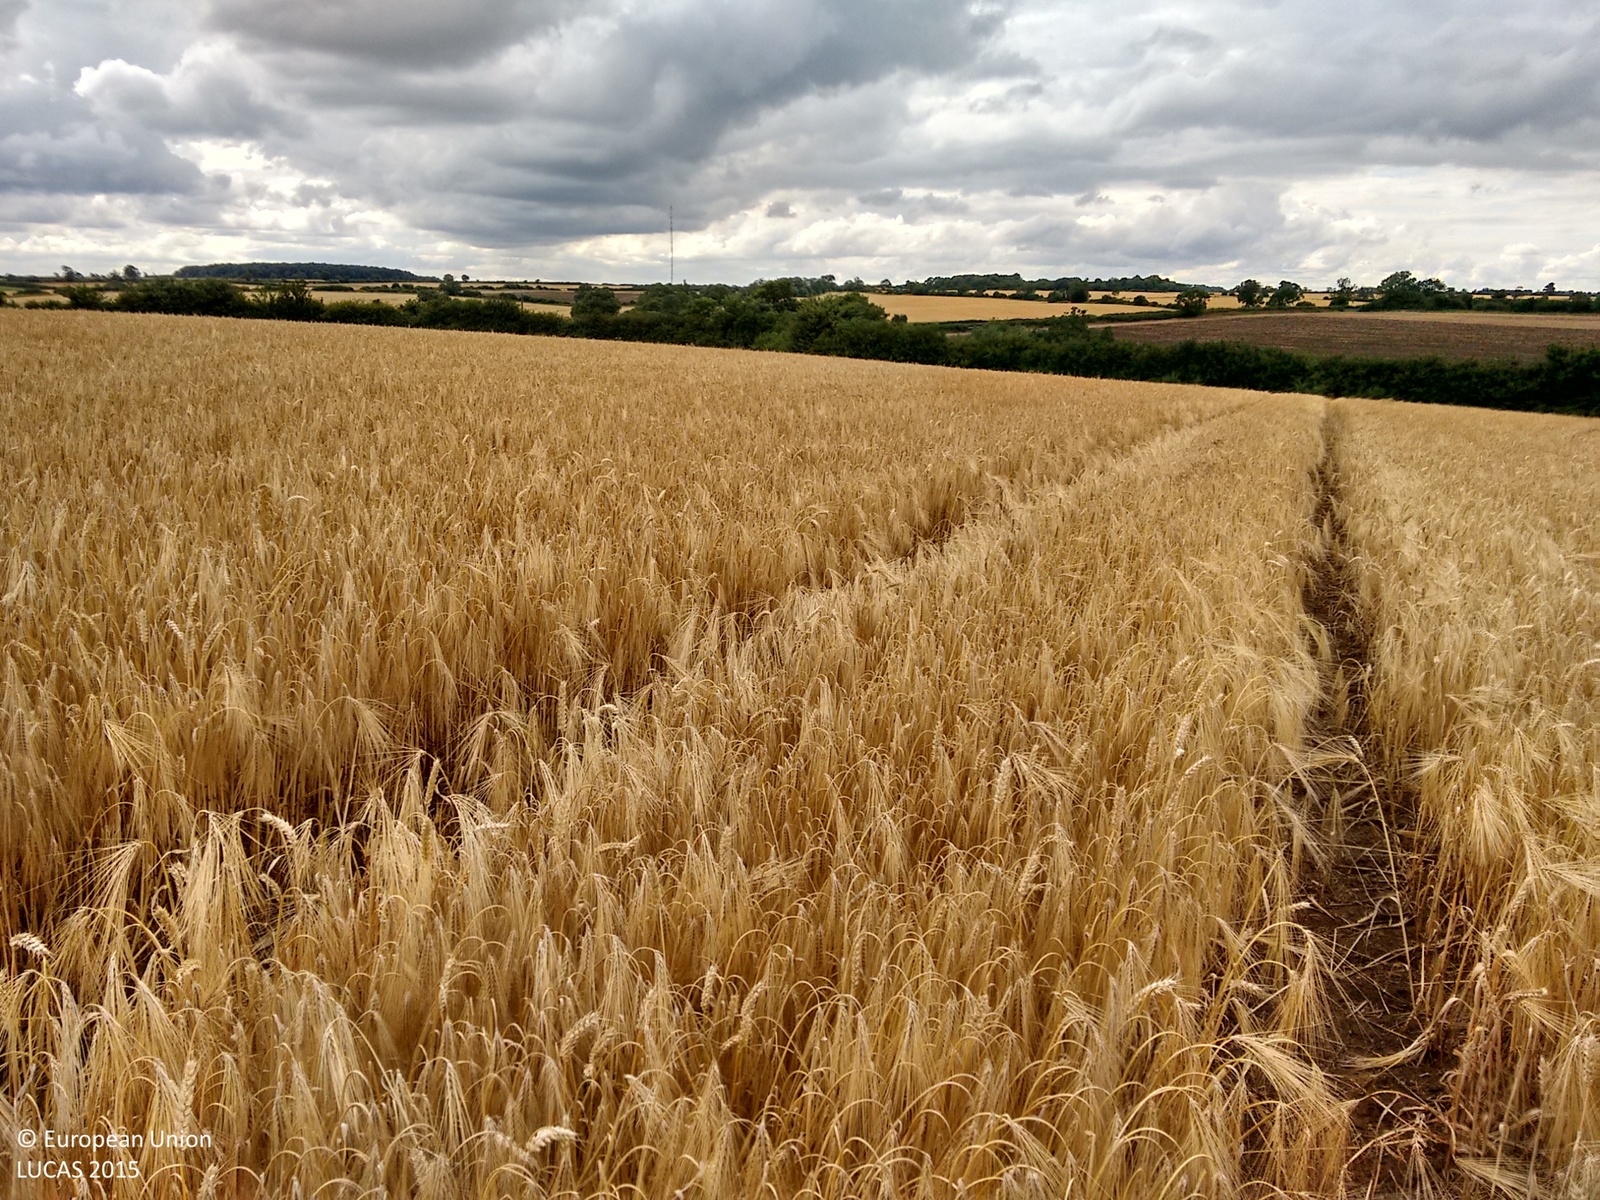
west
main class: Cropland
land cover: Mixed cereals for fodder
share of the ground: > 75 %
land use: Agriculture (excluding fallow land and kitchen gardens)
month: July
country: GB
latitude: 52.7964
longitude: -0.7337
